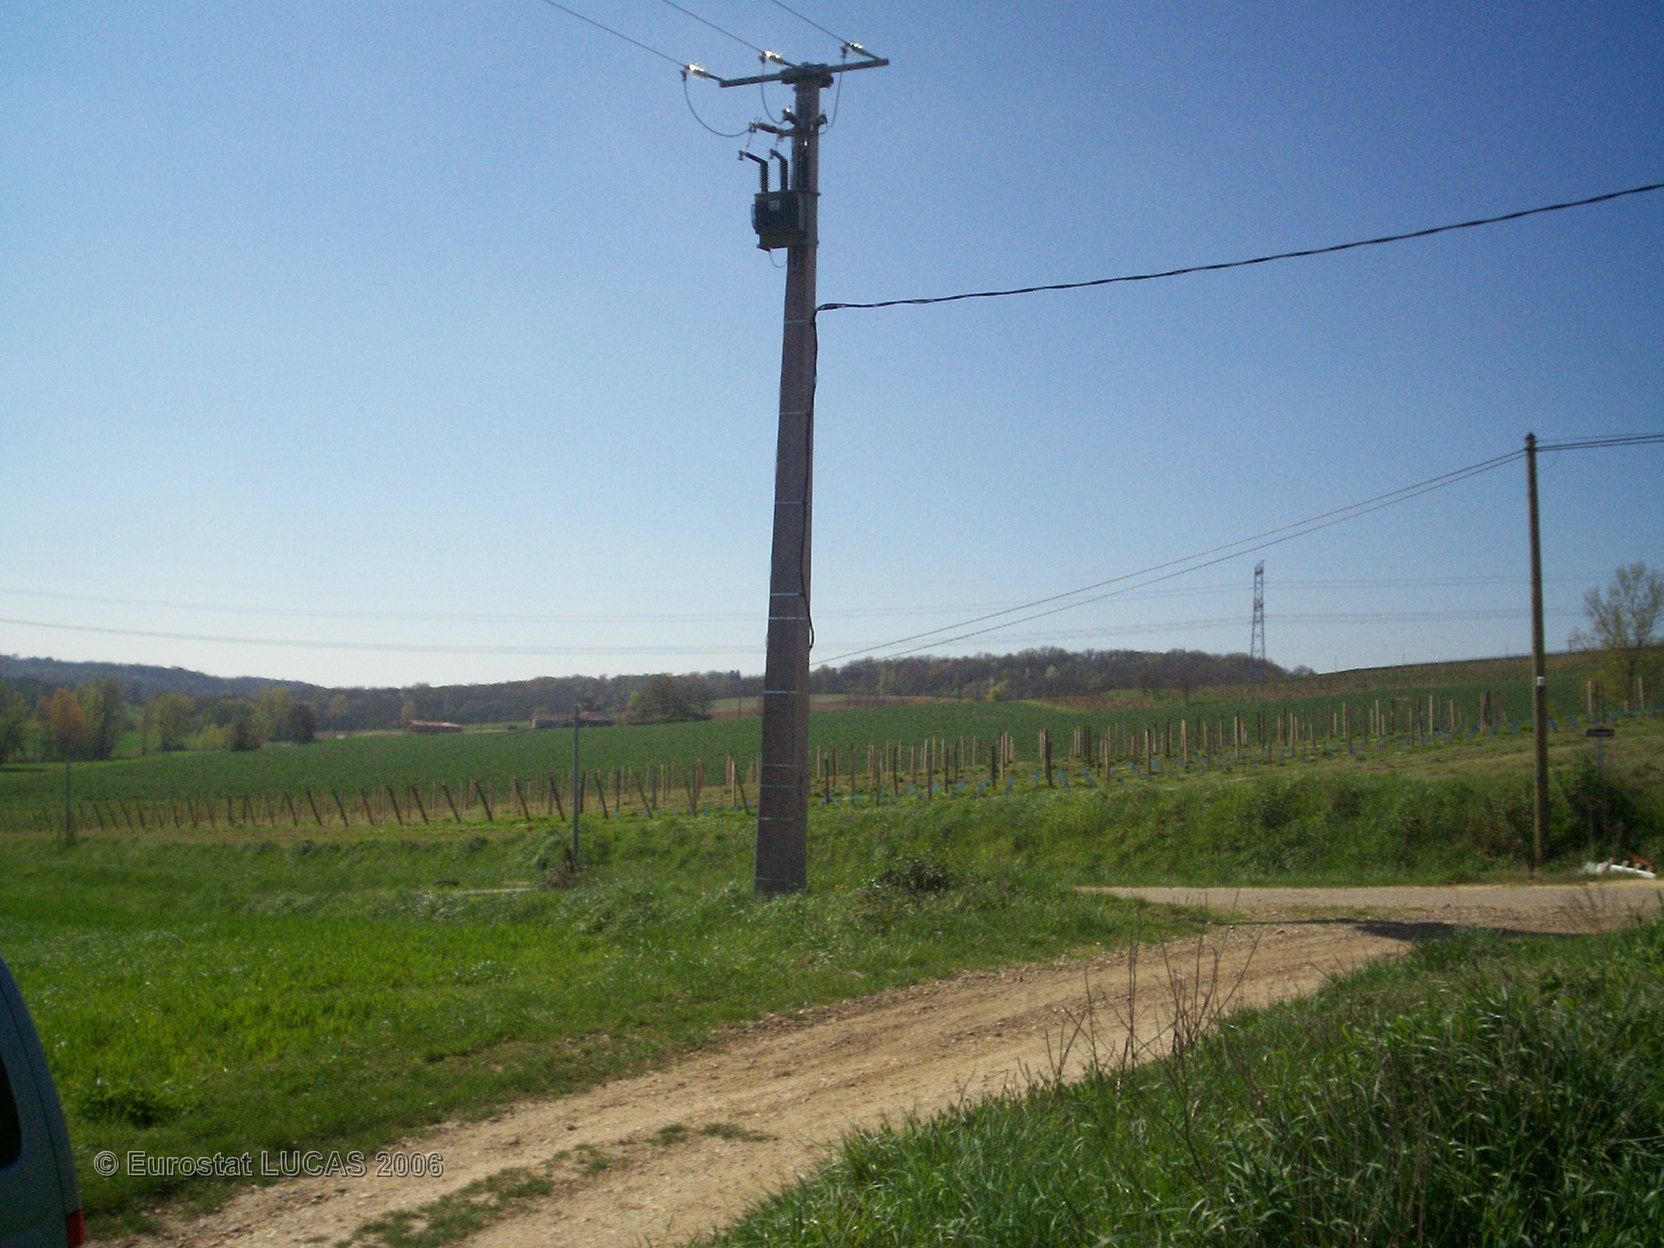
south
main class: Cropland
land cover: Common wheat
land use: Agriculture (excluding fallow land and kitchen gardens)
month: April
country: FR
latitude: 44.0677
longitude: 0.7950
